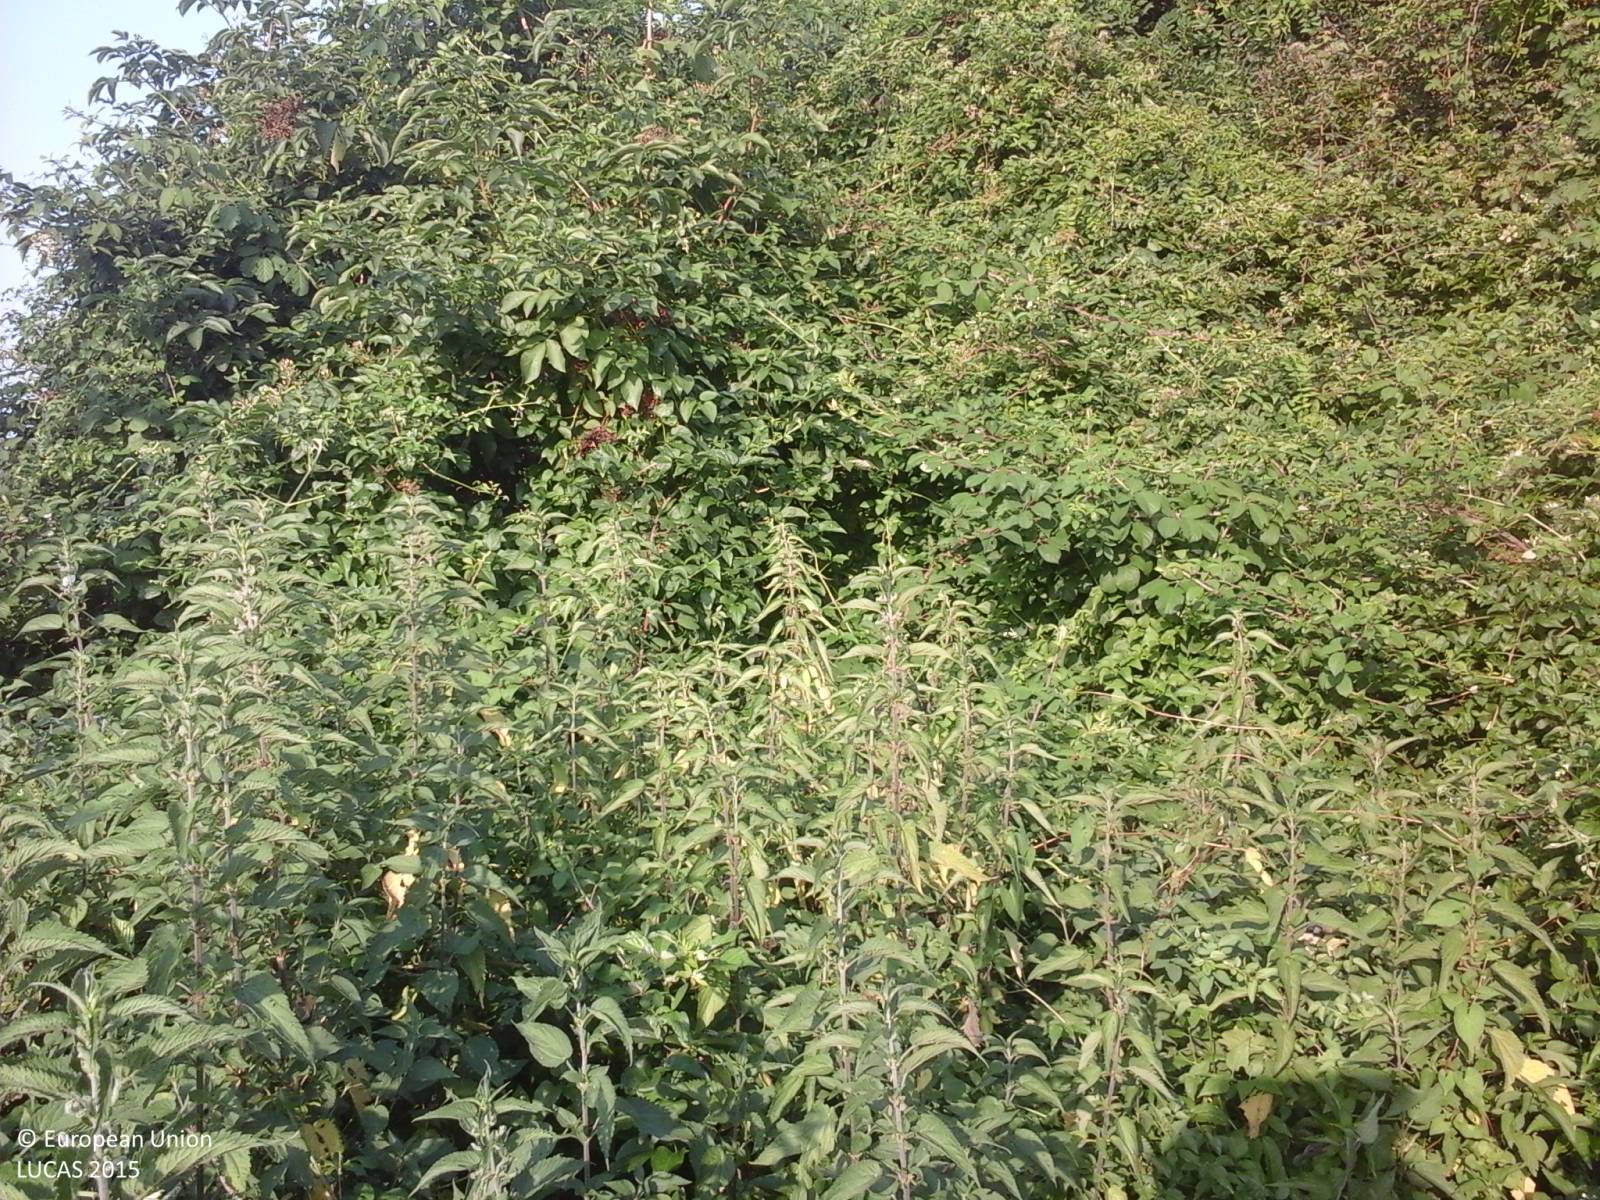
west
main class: Woodland
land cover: Broadleaved woodland
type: thermophilous deciduous forest
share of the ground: > 75 %
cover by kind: broadleaved forest trees 60 %, shrubs 40 %
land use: Forestry
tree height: > 5 m
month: July
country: IT
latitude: 46.1091
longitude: 13.0628
